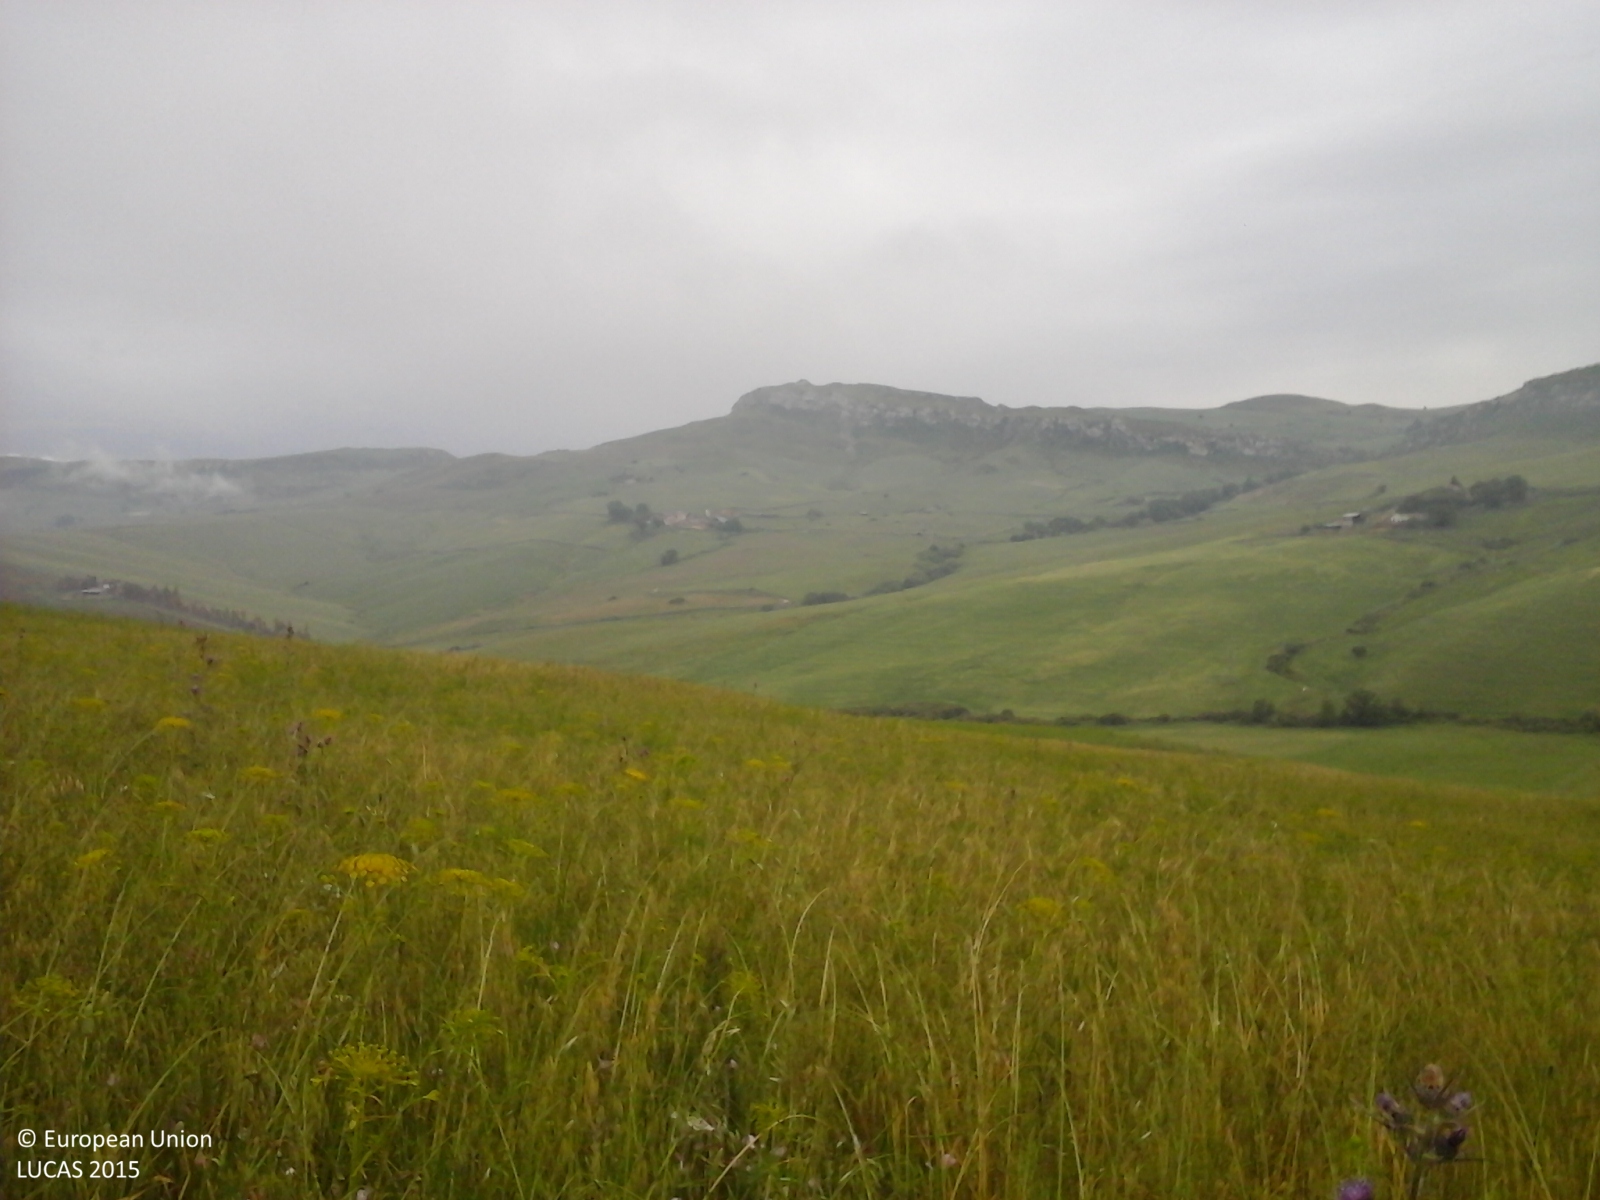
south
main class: Grassland
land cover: Spontaneously vegetated surfaces
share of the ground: > 75 %
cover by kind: herbaceous plants 100 %
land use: Fallow land
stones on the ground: < 10 %
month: May
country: IT
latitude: 37.7561
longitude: 13.9554
